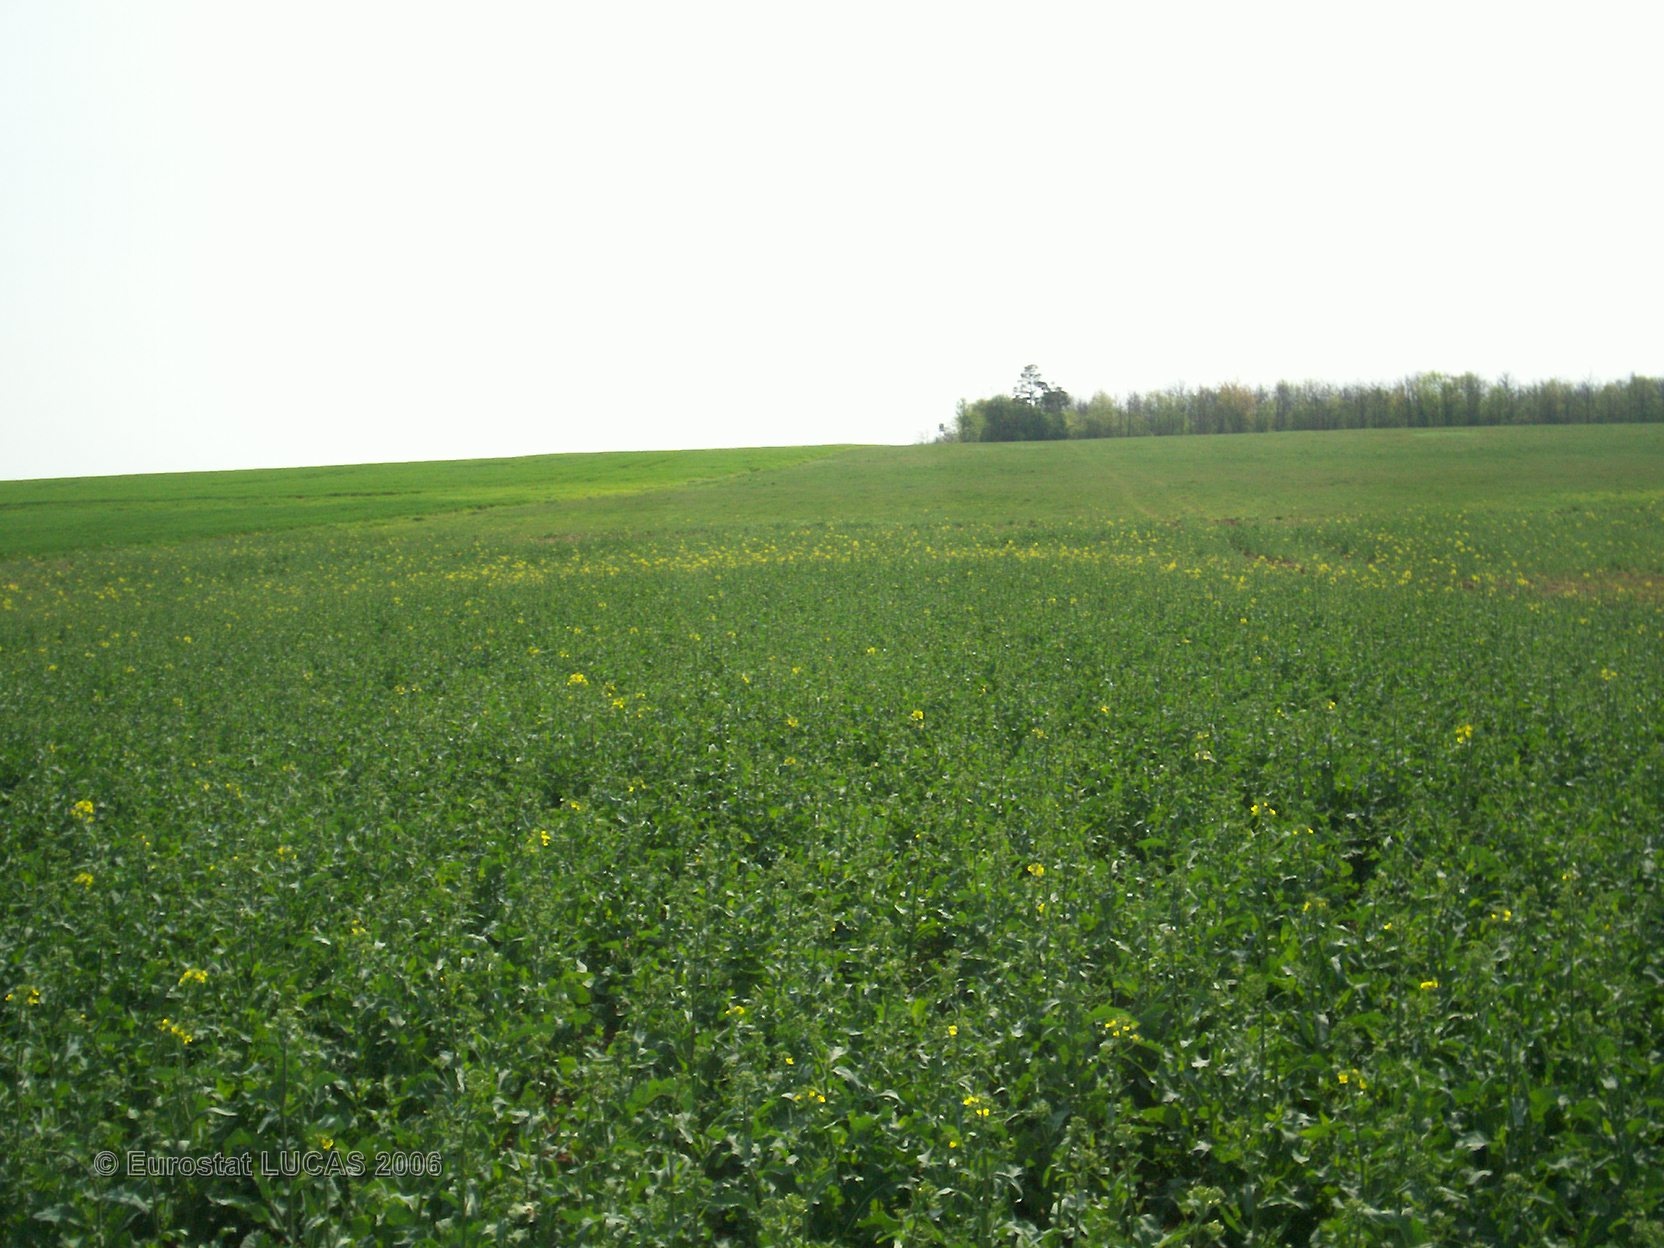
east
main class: Cropland
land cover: Rape and turnip rape
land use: Agriculture (excluding fallow land and kitchen gardens)
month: May
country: FR
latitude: 47.6035
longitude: 4.5854
